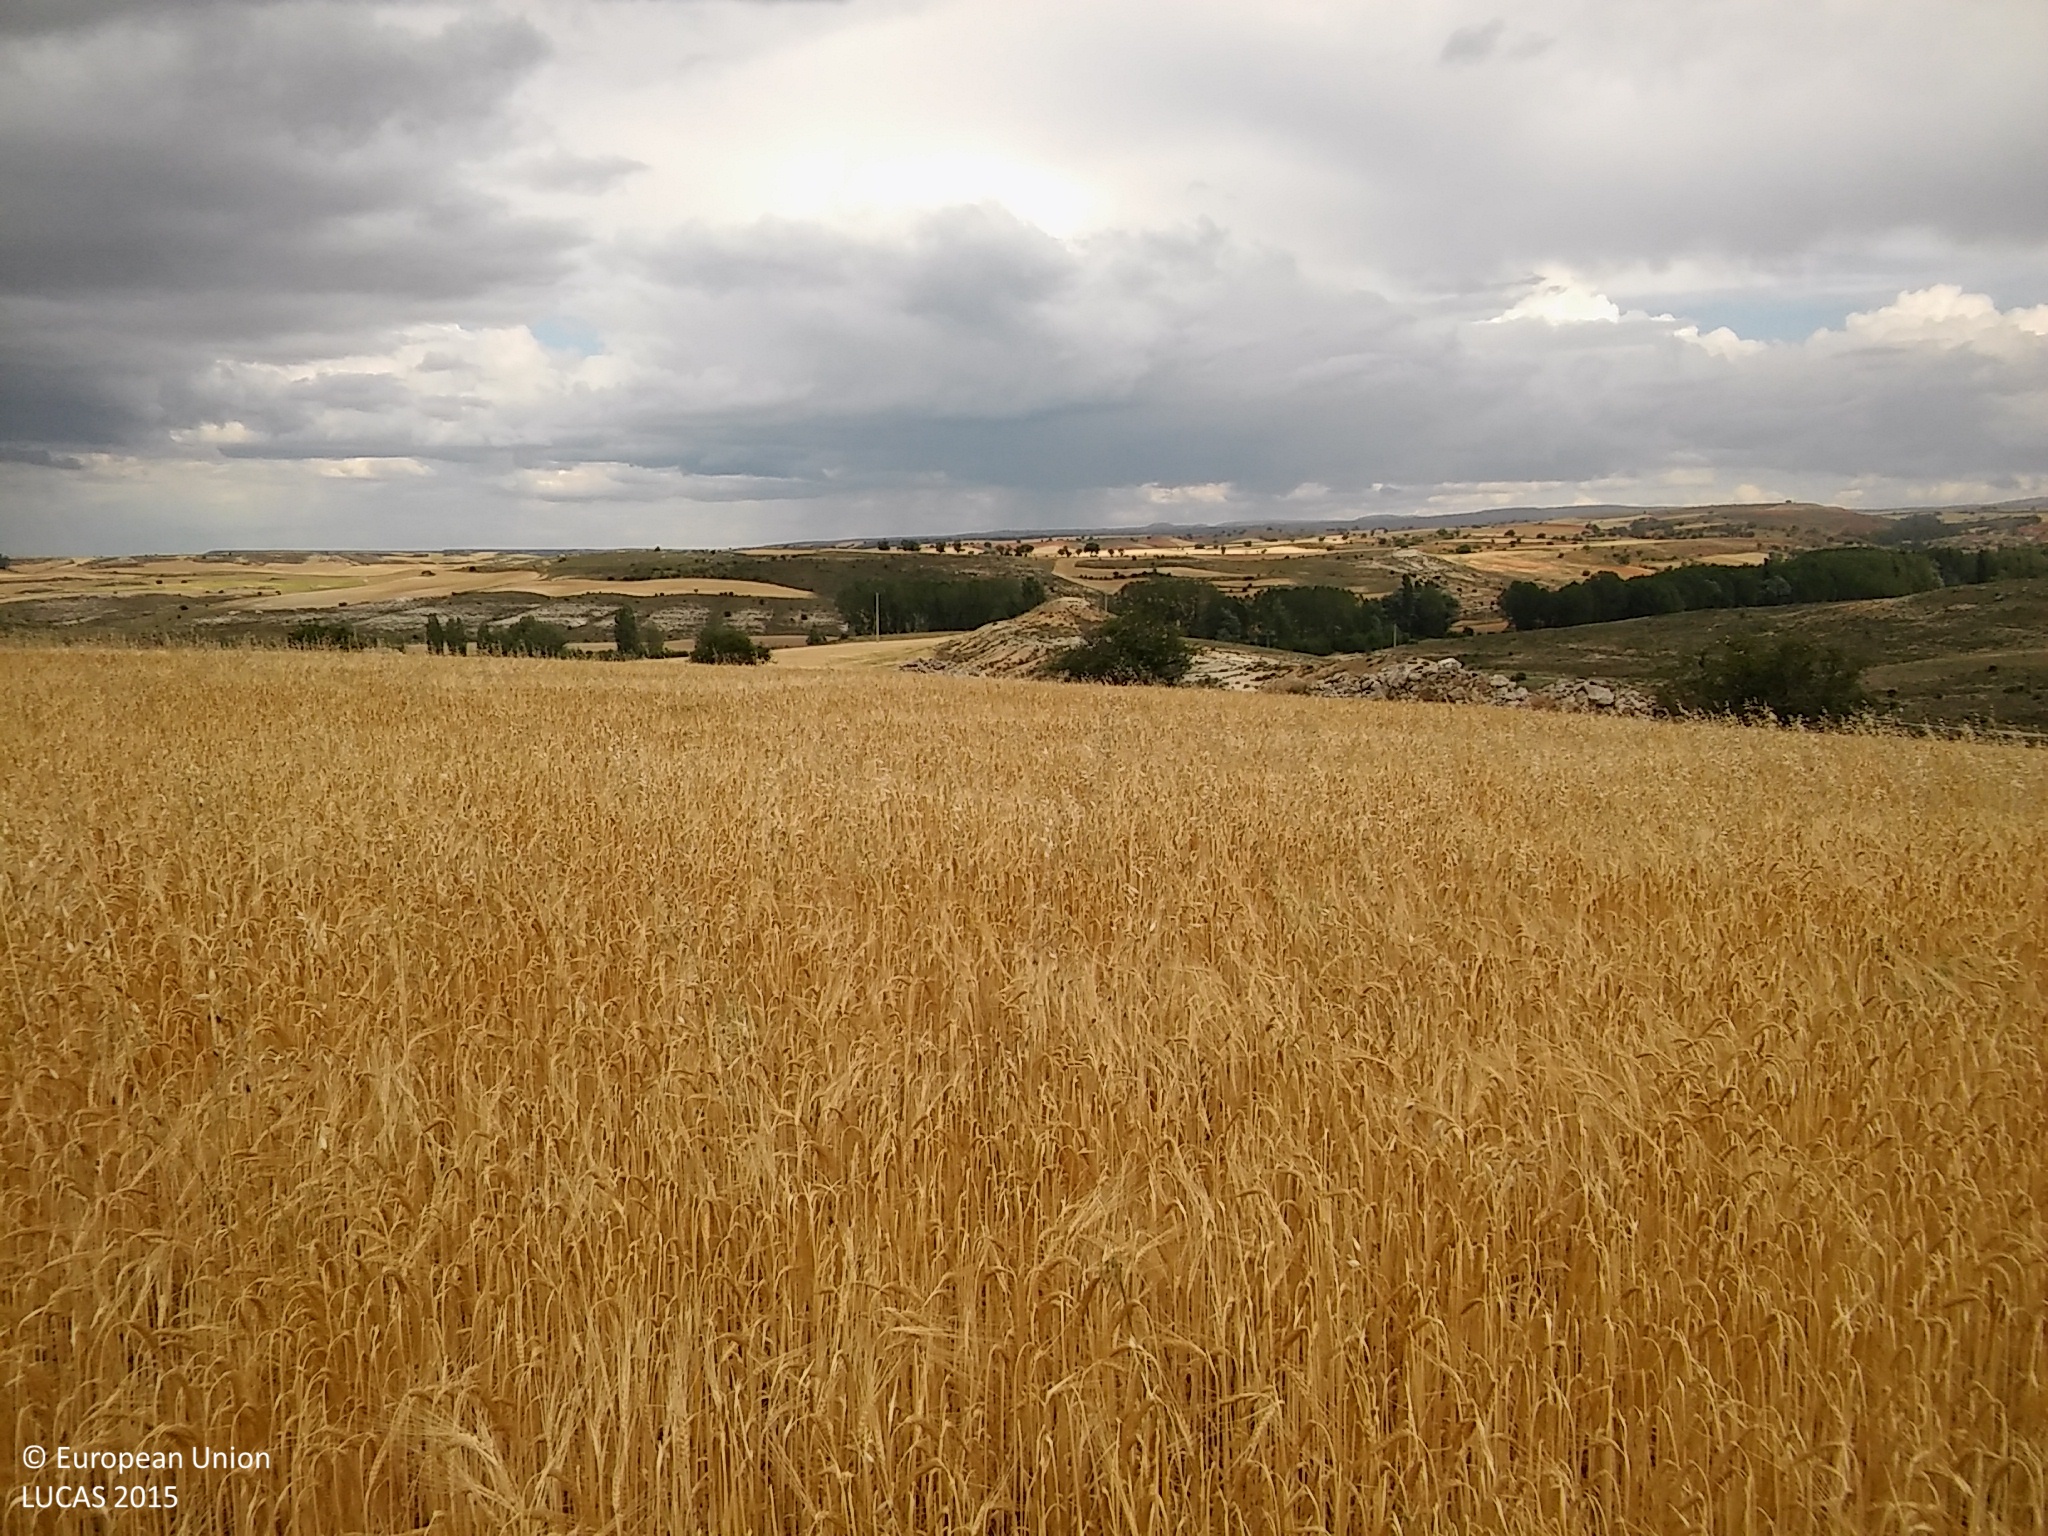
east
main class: Cropland
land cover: Barley
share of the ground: > 75 %
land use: Agriculture (excluding fallow land and kitchen gardens)
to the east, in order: Barley; Dry stone walls; Shrubland without tree cover; Barley
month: June
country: ES
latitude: 41.5427
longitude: -3.7781
